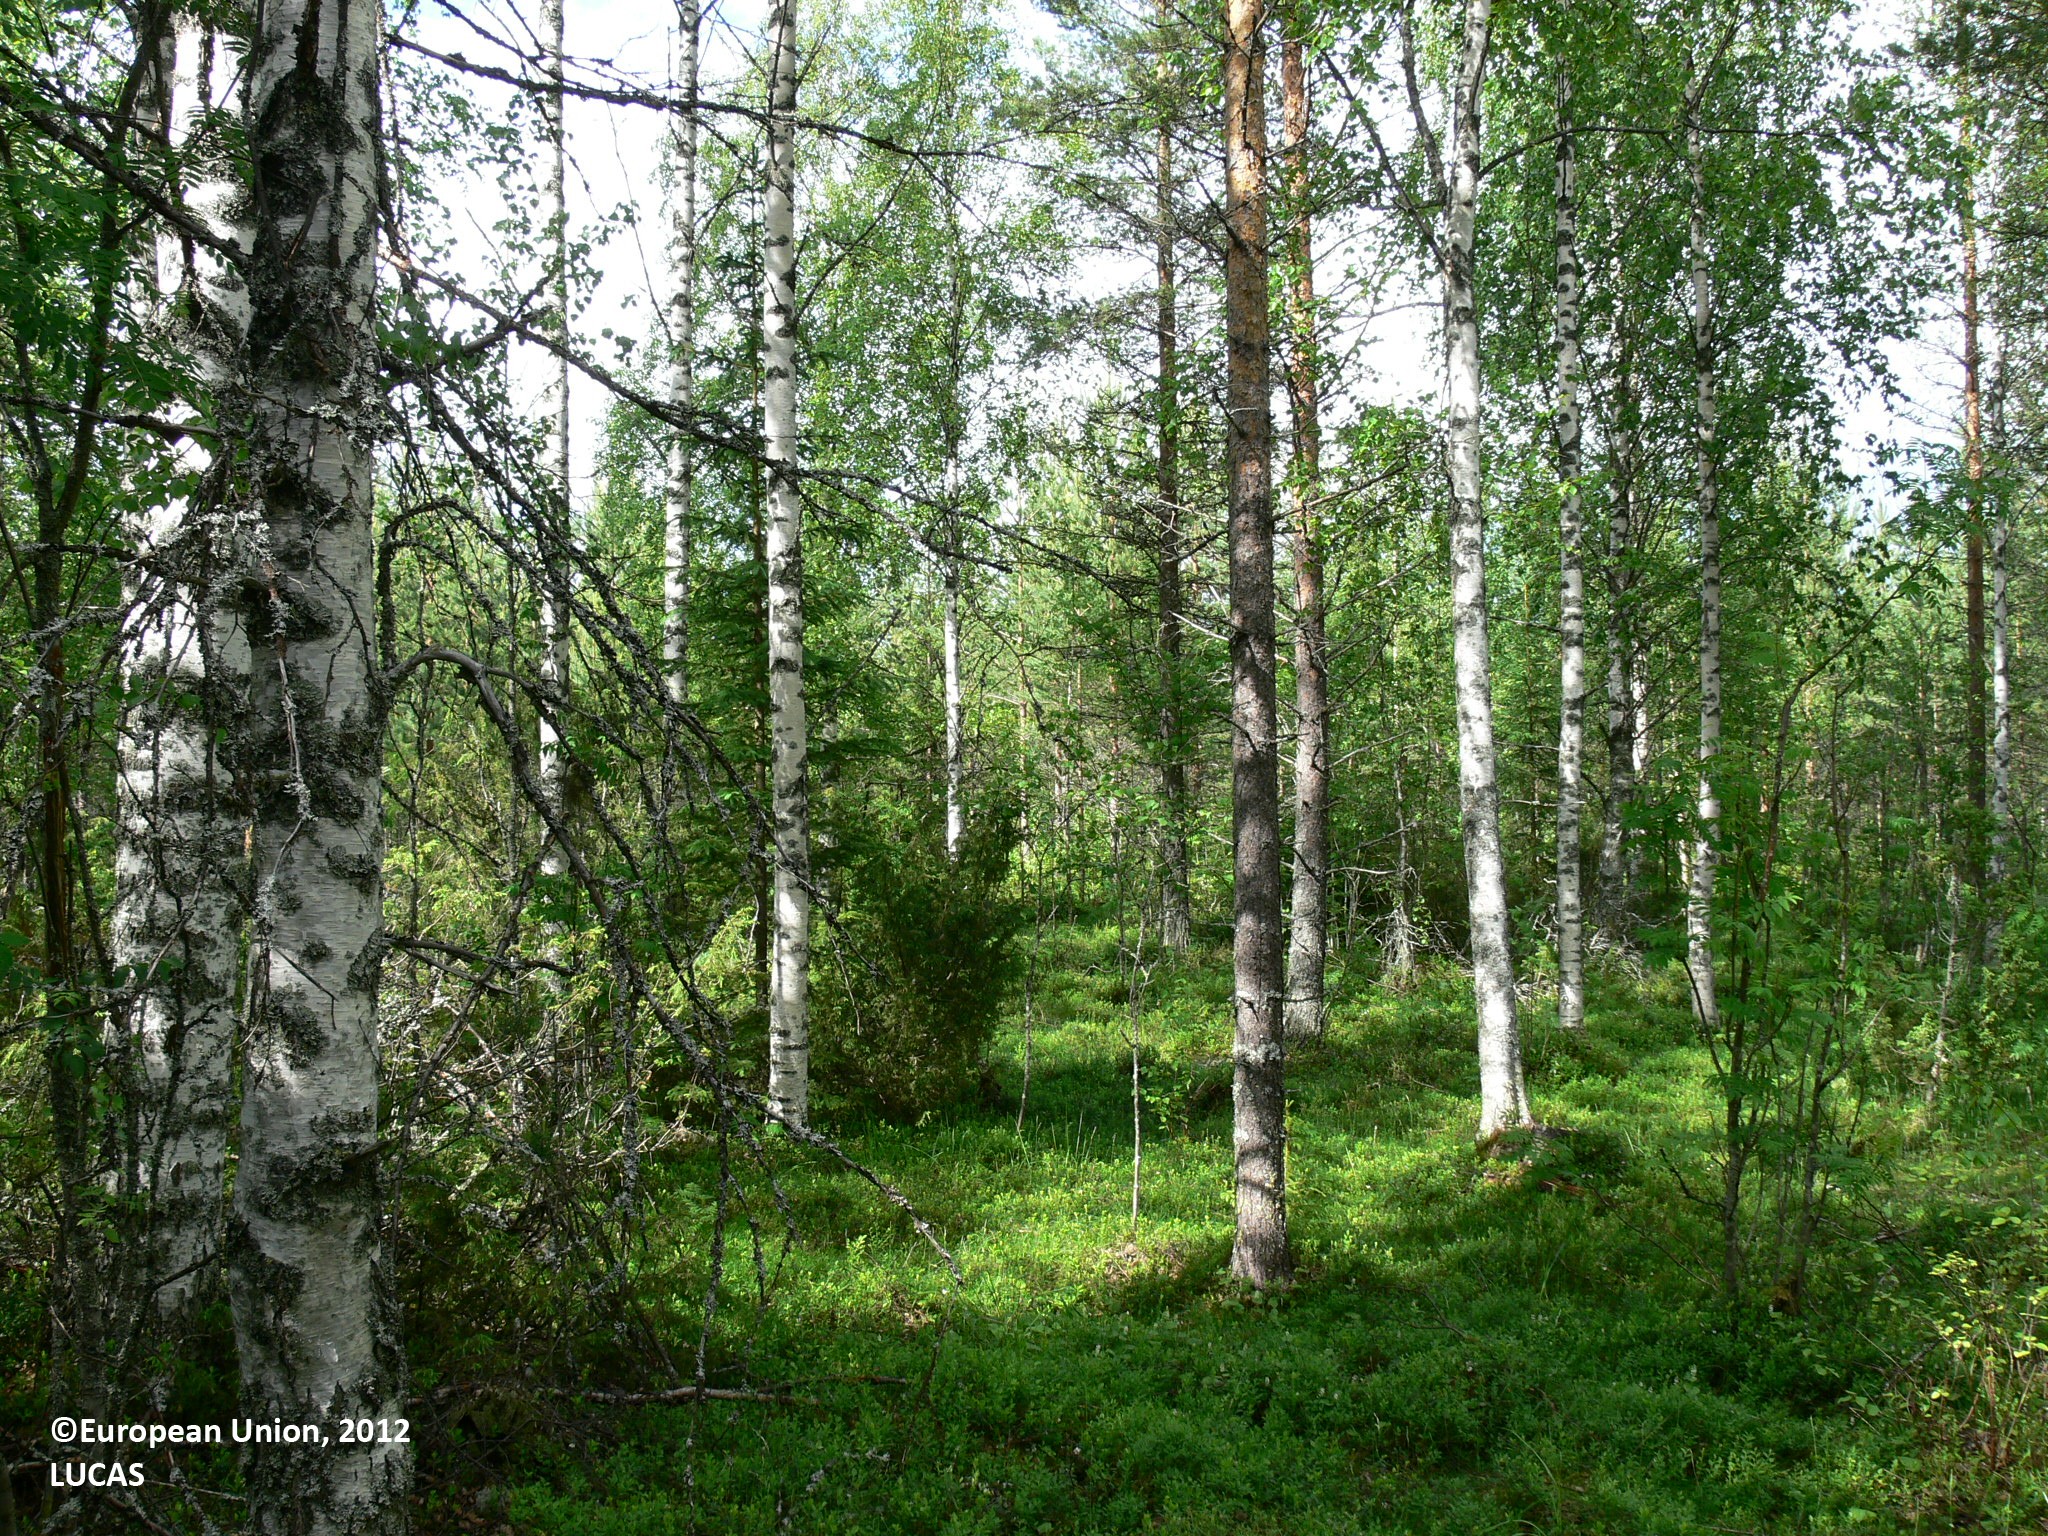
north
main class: Woodland
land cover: Other mixed woodland
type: boreal forest
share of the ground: 50 - 75 %
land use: Forestry
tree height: > 5 m
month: June
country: FI
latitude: 62.7340
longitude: 30.4908
